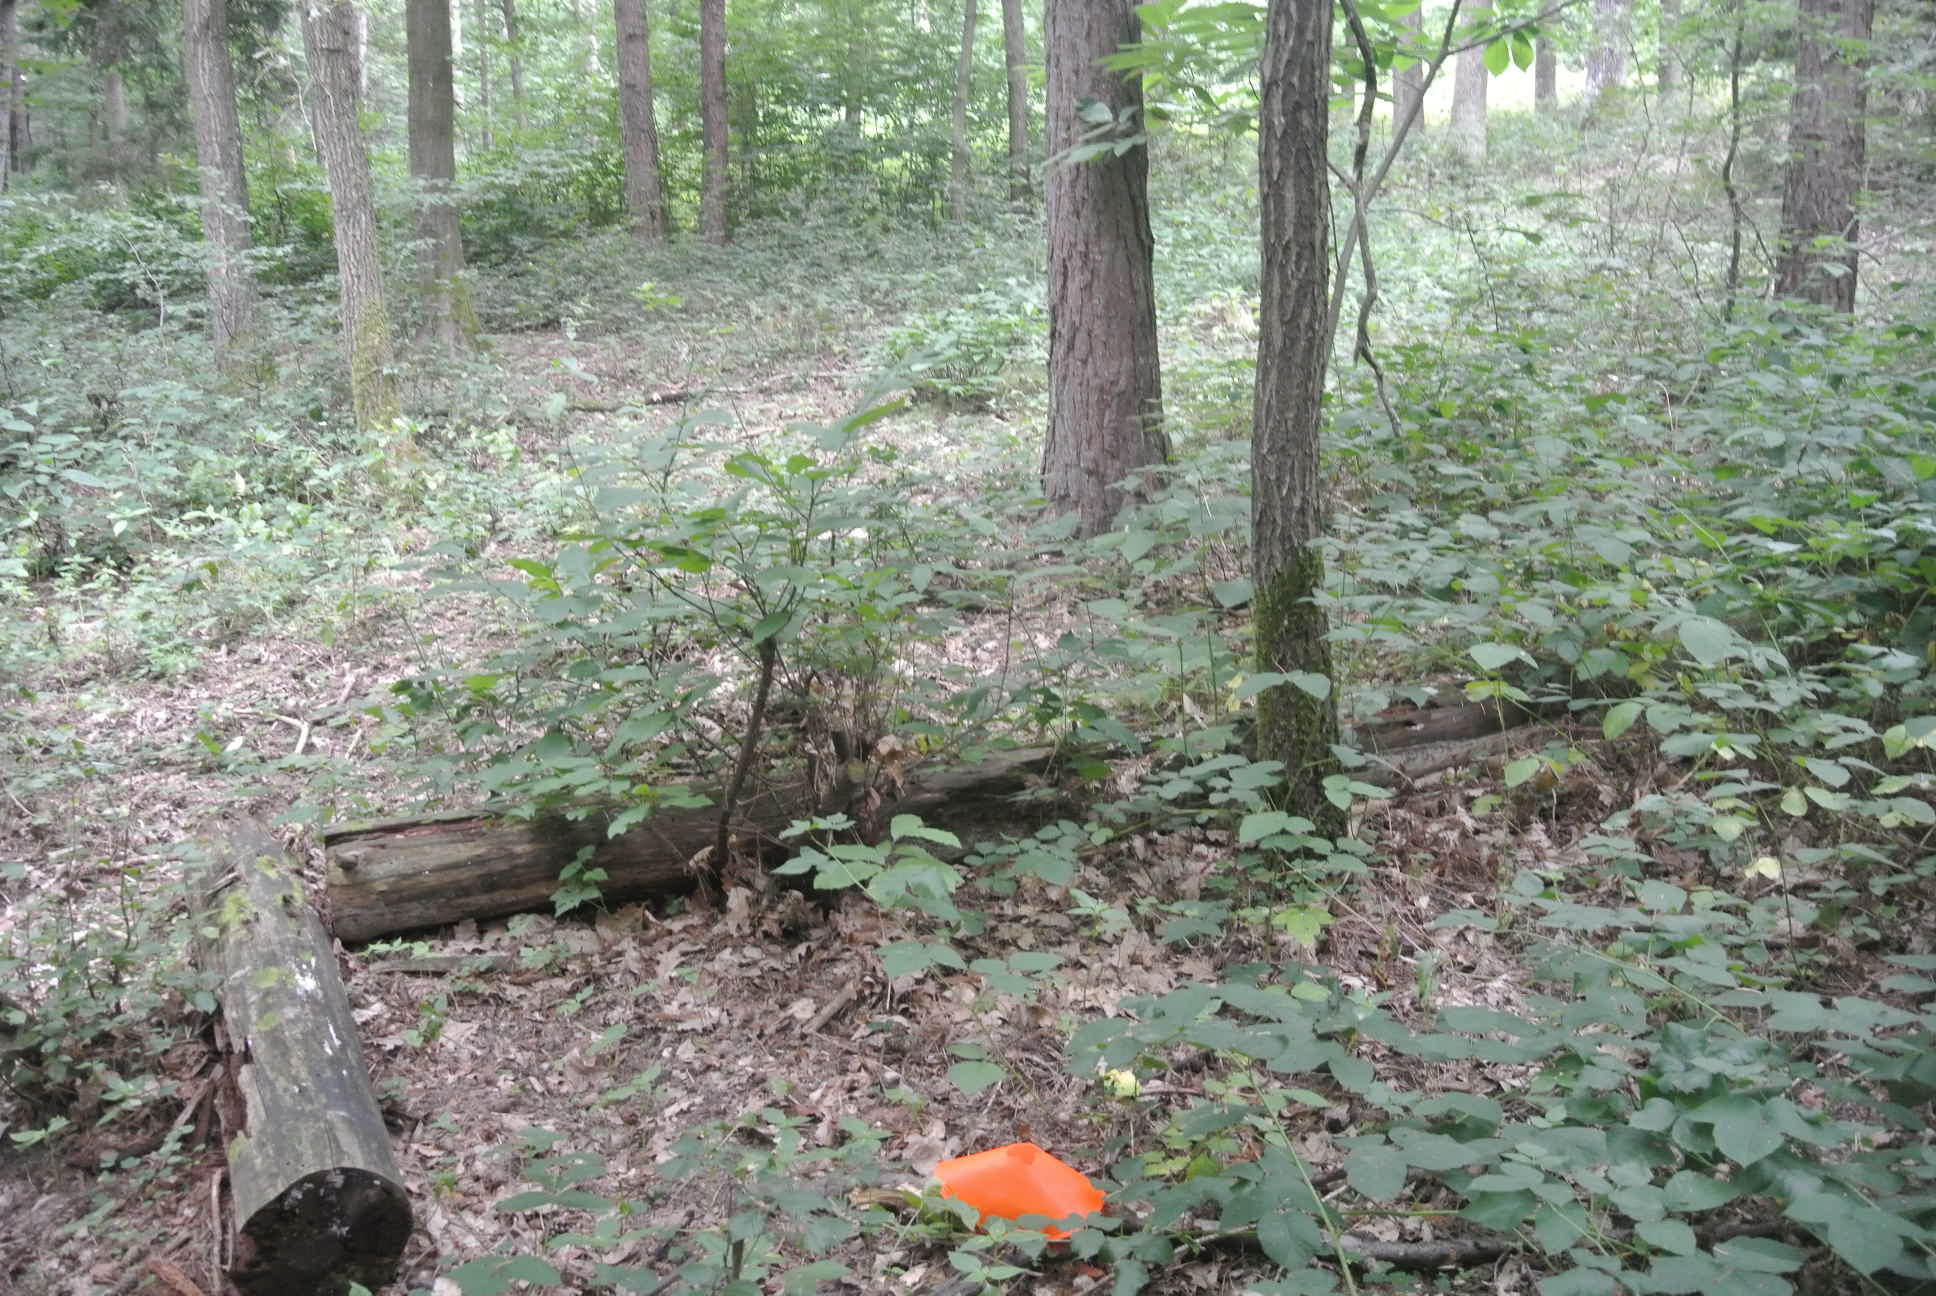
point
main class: Woodland
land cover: Pine dominated mixed woodland
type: alpine coniferous forest
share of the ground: > 75 %
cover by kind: coniferous forest trees 60 %, broadleaved forest trees 40 %
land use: Forestry
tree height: > 5 m
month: July
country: AT
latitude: 47.5115
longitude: 16.4435
